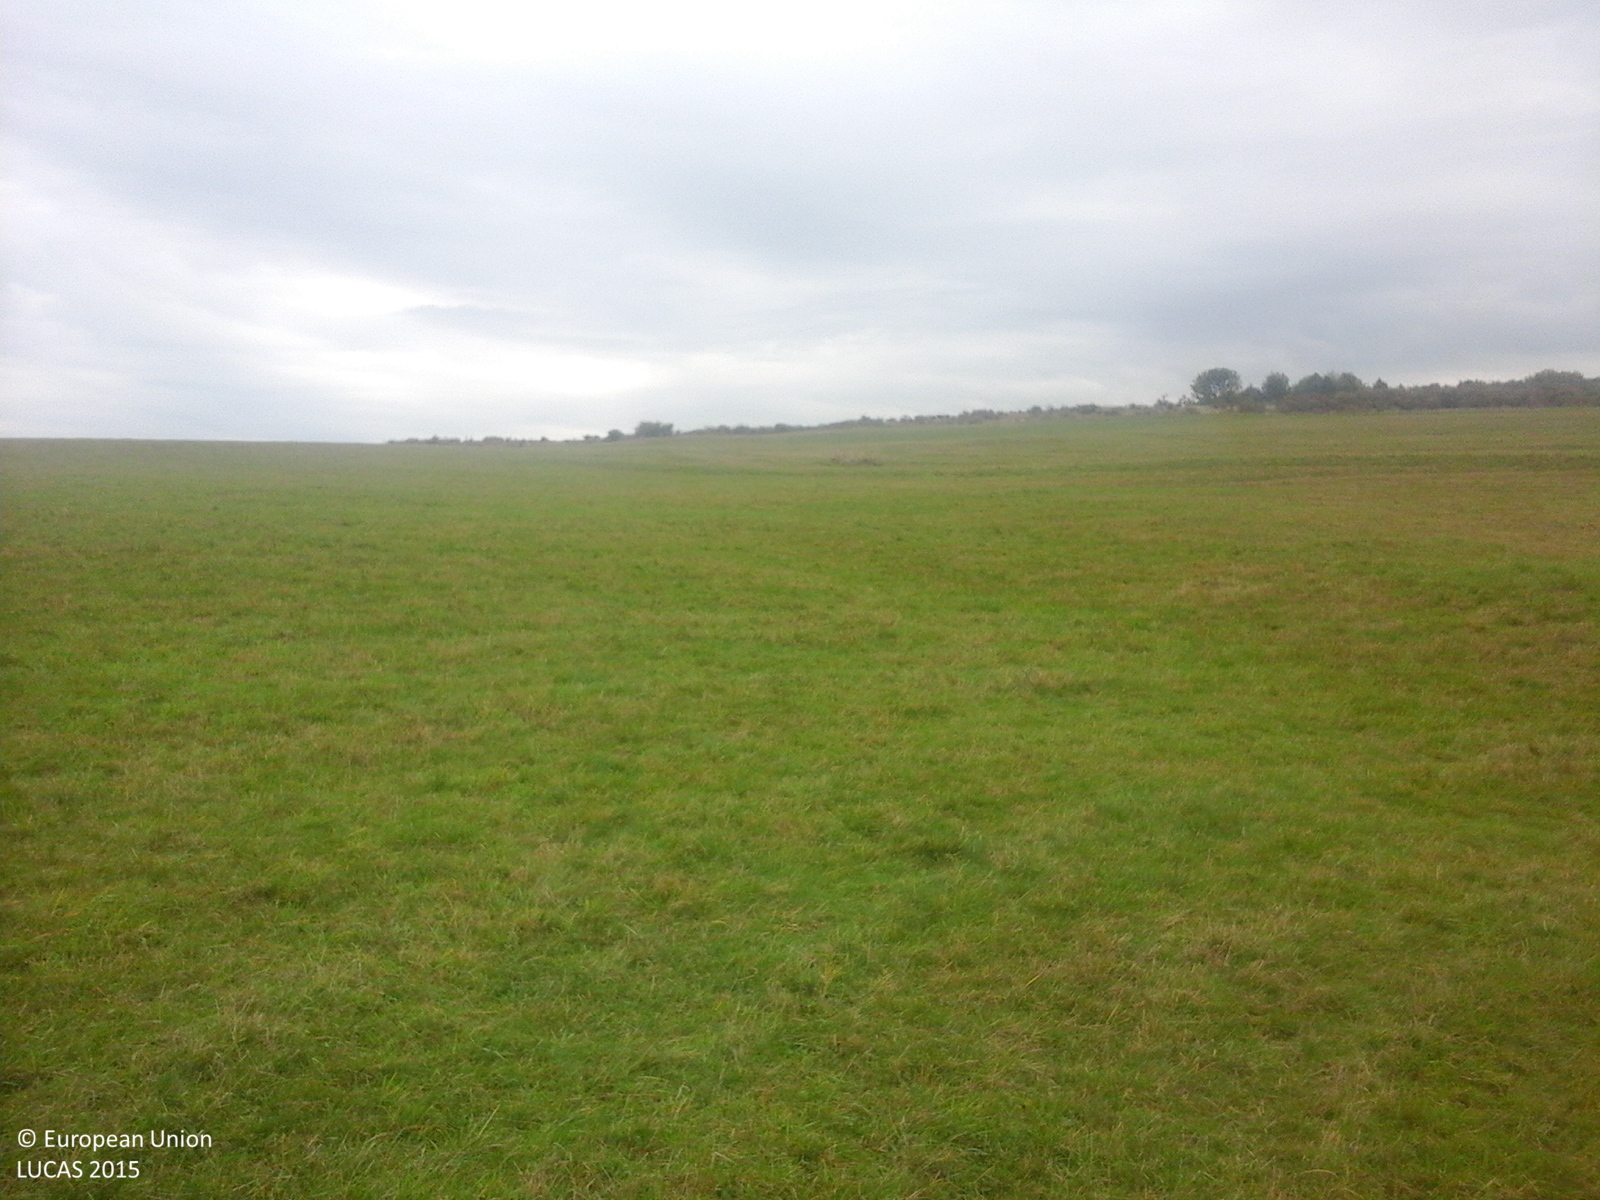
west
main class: Grassland
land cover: Grassland without tree/shrub cover
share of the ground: > 75 %
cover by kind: herbaceous plants 100 %
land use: Agriculture (excluding fallow land and kitchen gardens)
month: October
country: RO
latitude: 46.5836
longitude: 25.0148
